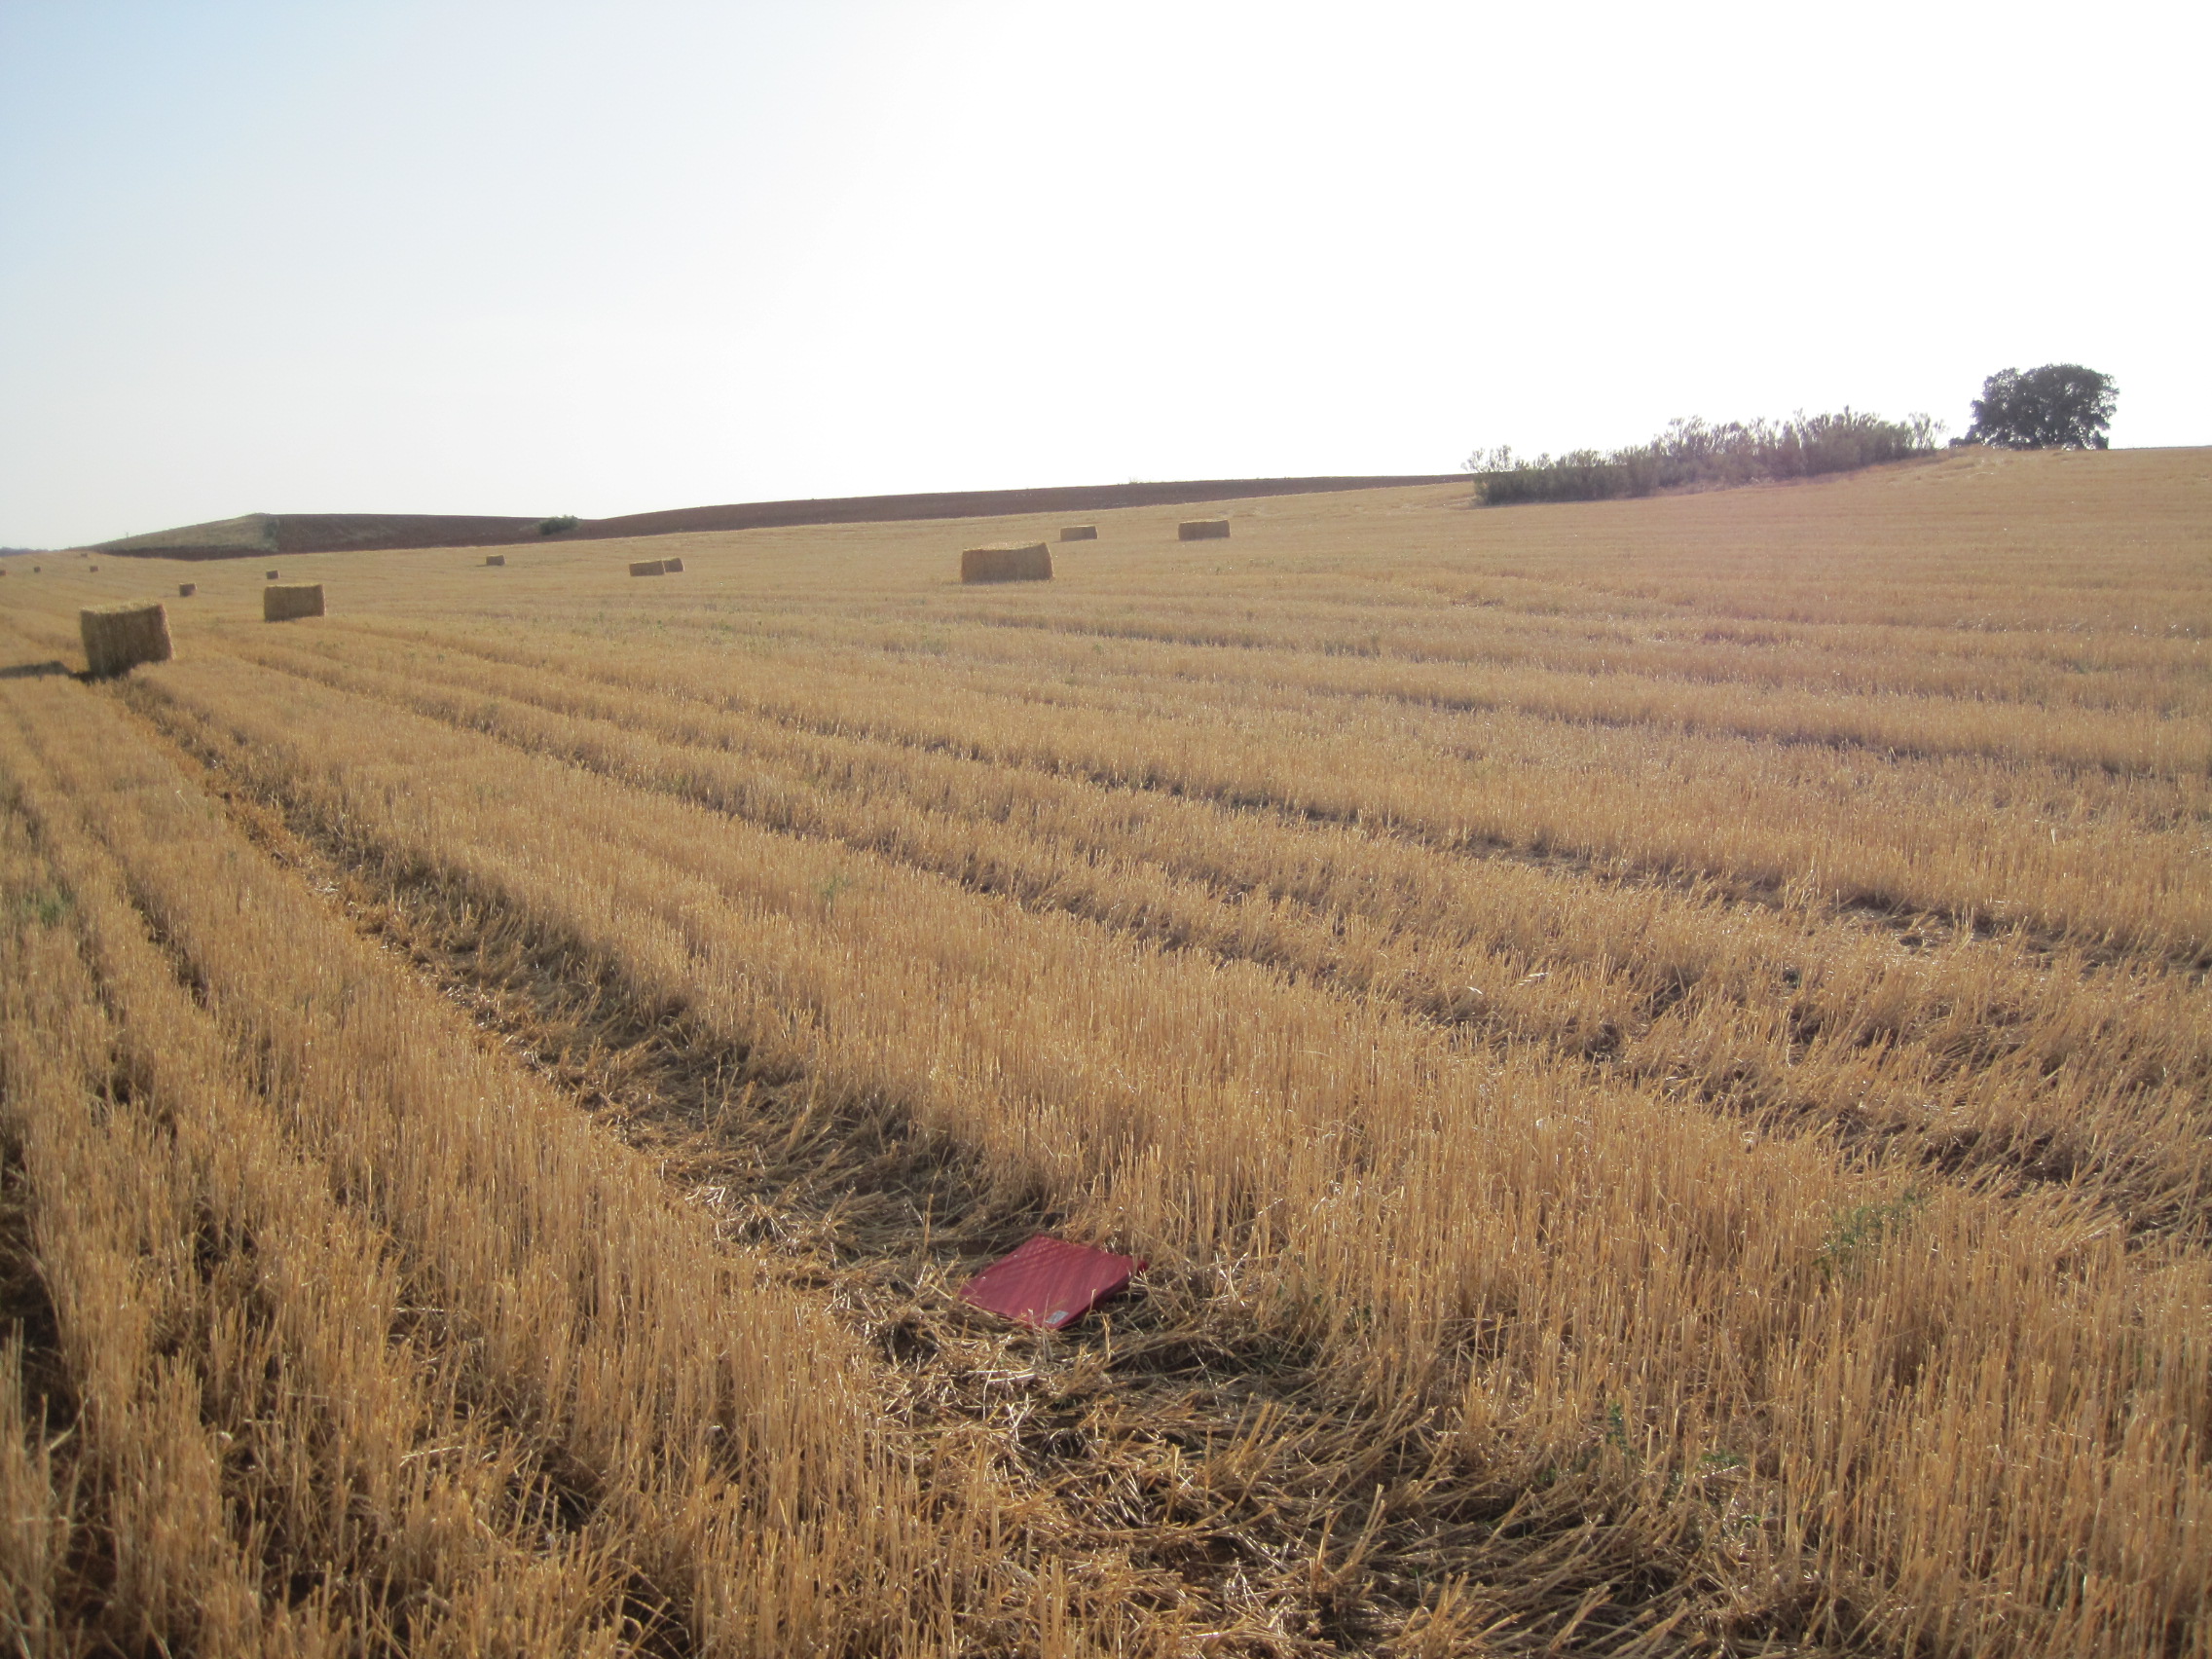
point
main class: Cropland
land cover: Common wheat
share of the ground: < 10 %
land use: Agriculture (excluding fallow land and kitchen gardens)
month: July
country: ES
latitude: 41.7015
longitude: -5.5508
